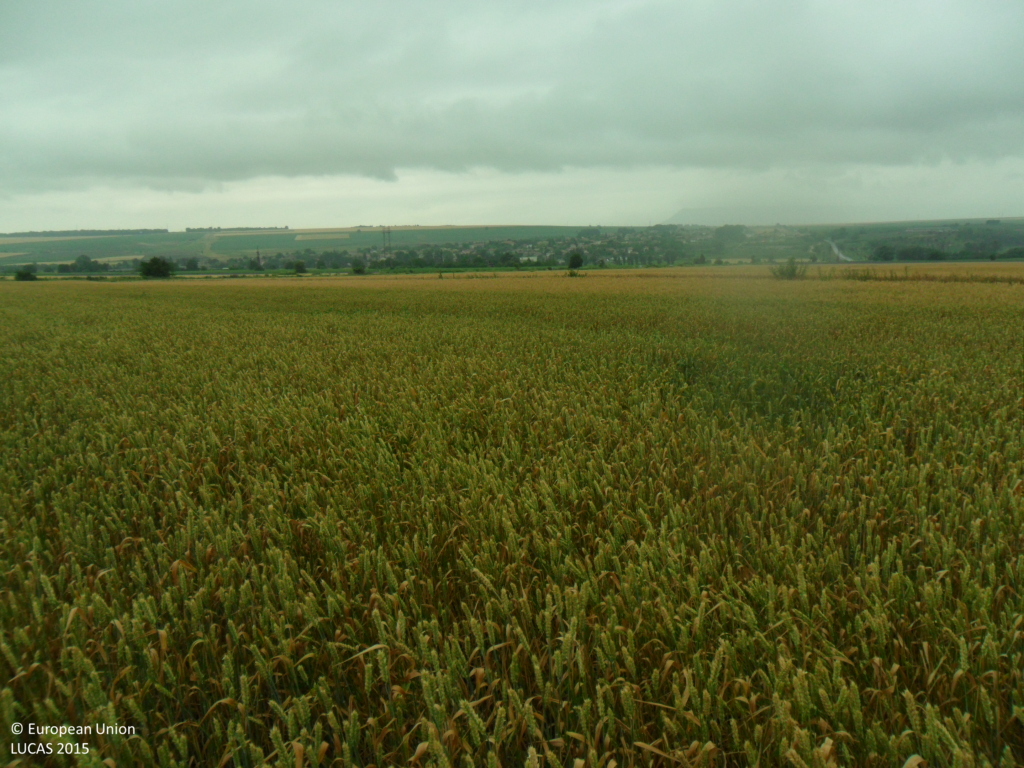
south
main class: Cropland
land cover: Common wheat
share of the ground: > 75 %
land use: Agriculture (excluding fallow land and kitchen gardens)
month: June
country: BG
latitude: 43.3222
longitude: 26.9968
